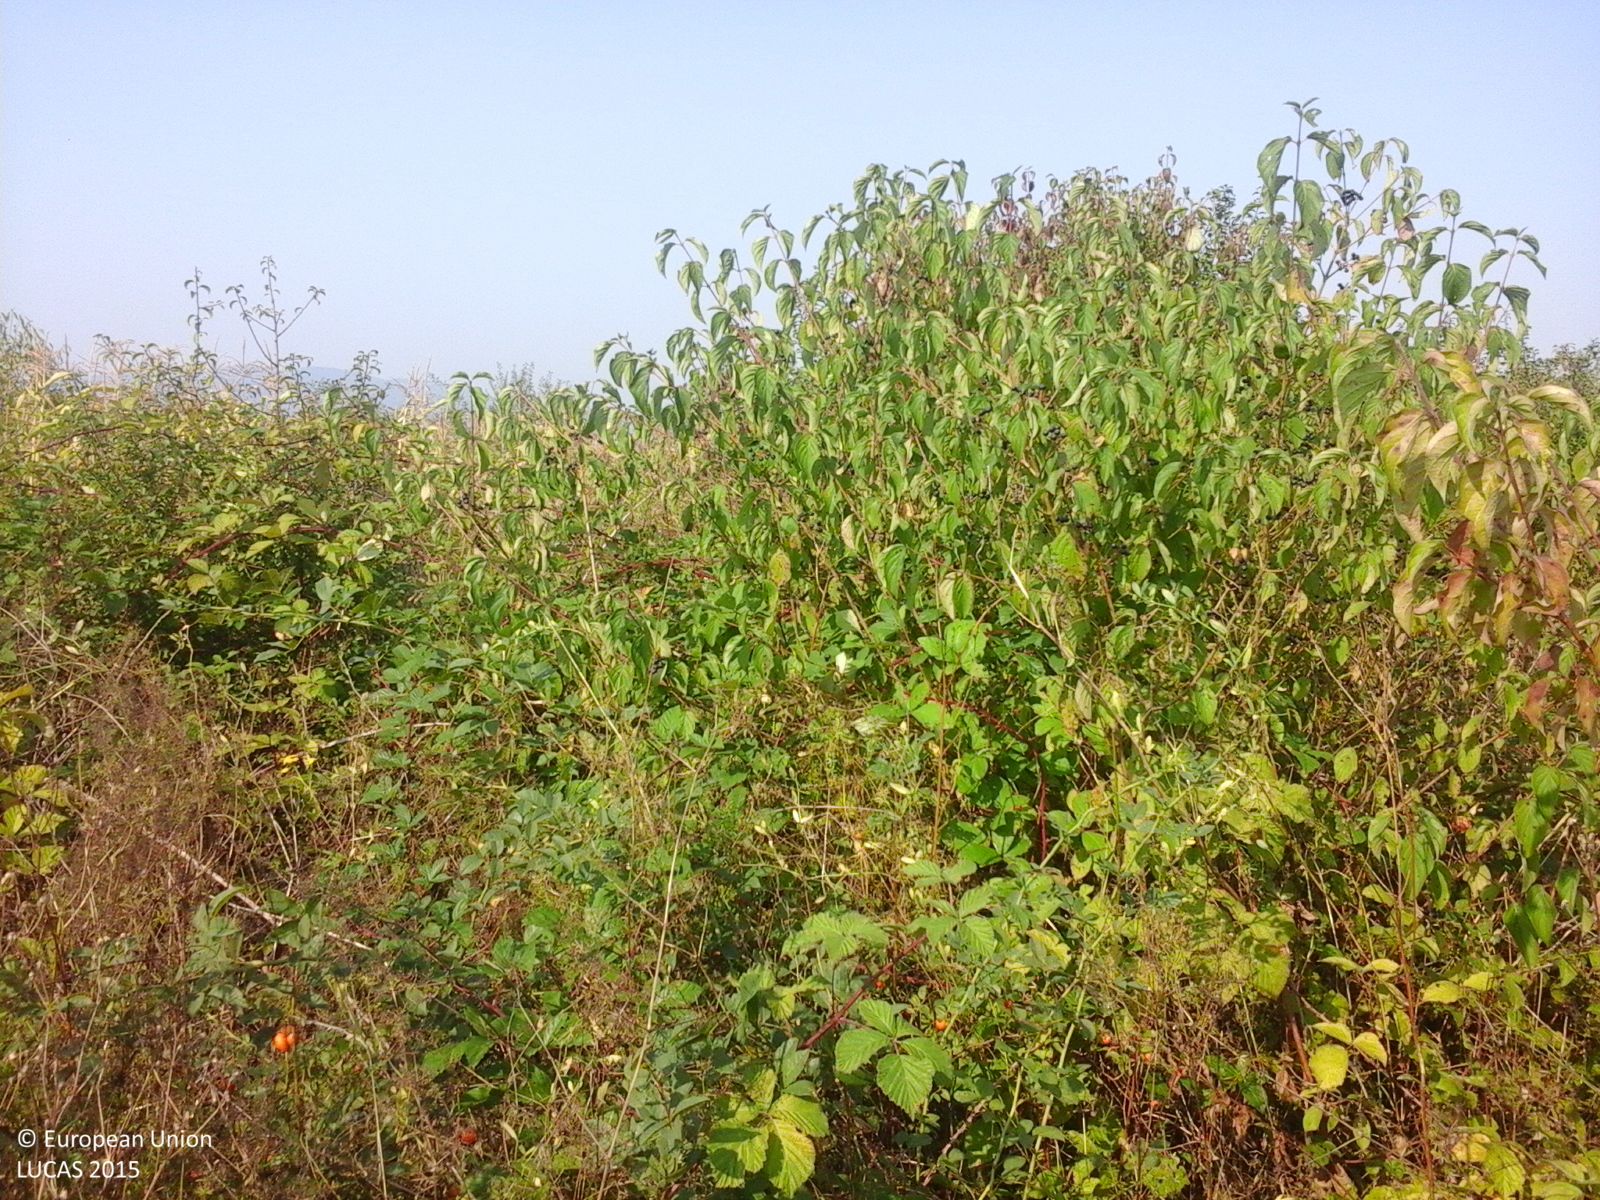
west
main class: Grassland
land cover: Grassland with sparse tree/shrub cover
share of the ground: > 75 %
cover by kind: herbaceous plants 85 %, shrubs 10 %, broadleaved forest trees 5 %
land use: Agriculture (excluding fallow land and kitchen gardens)
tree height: < 5 m
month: August
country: RO
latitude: 46.3128
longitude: 22.2930
